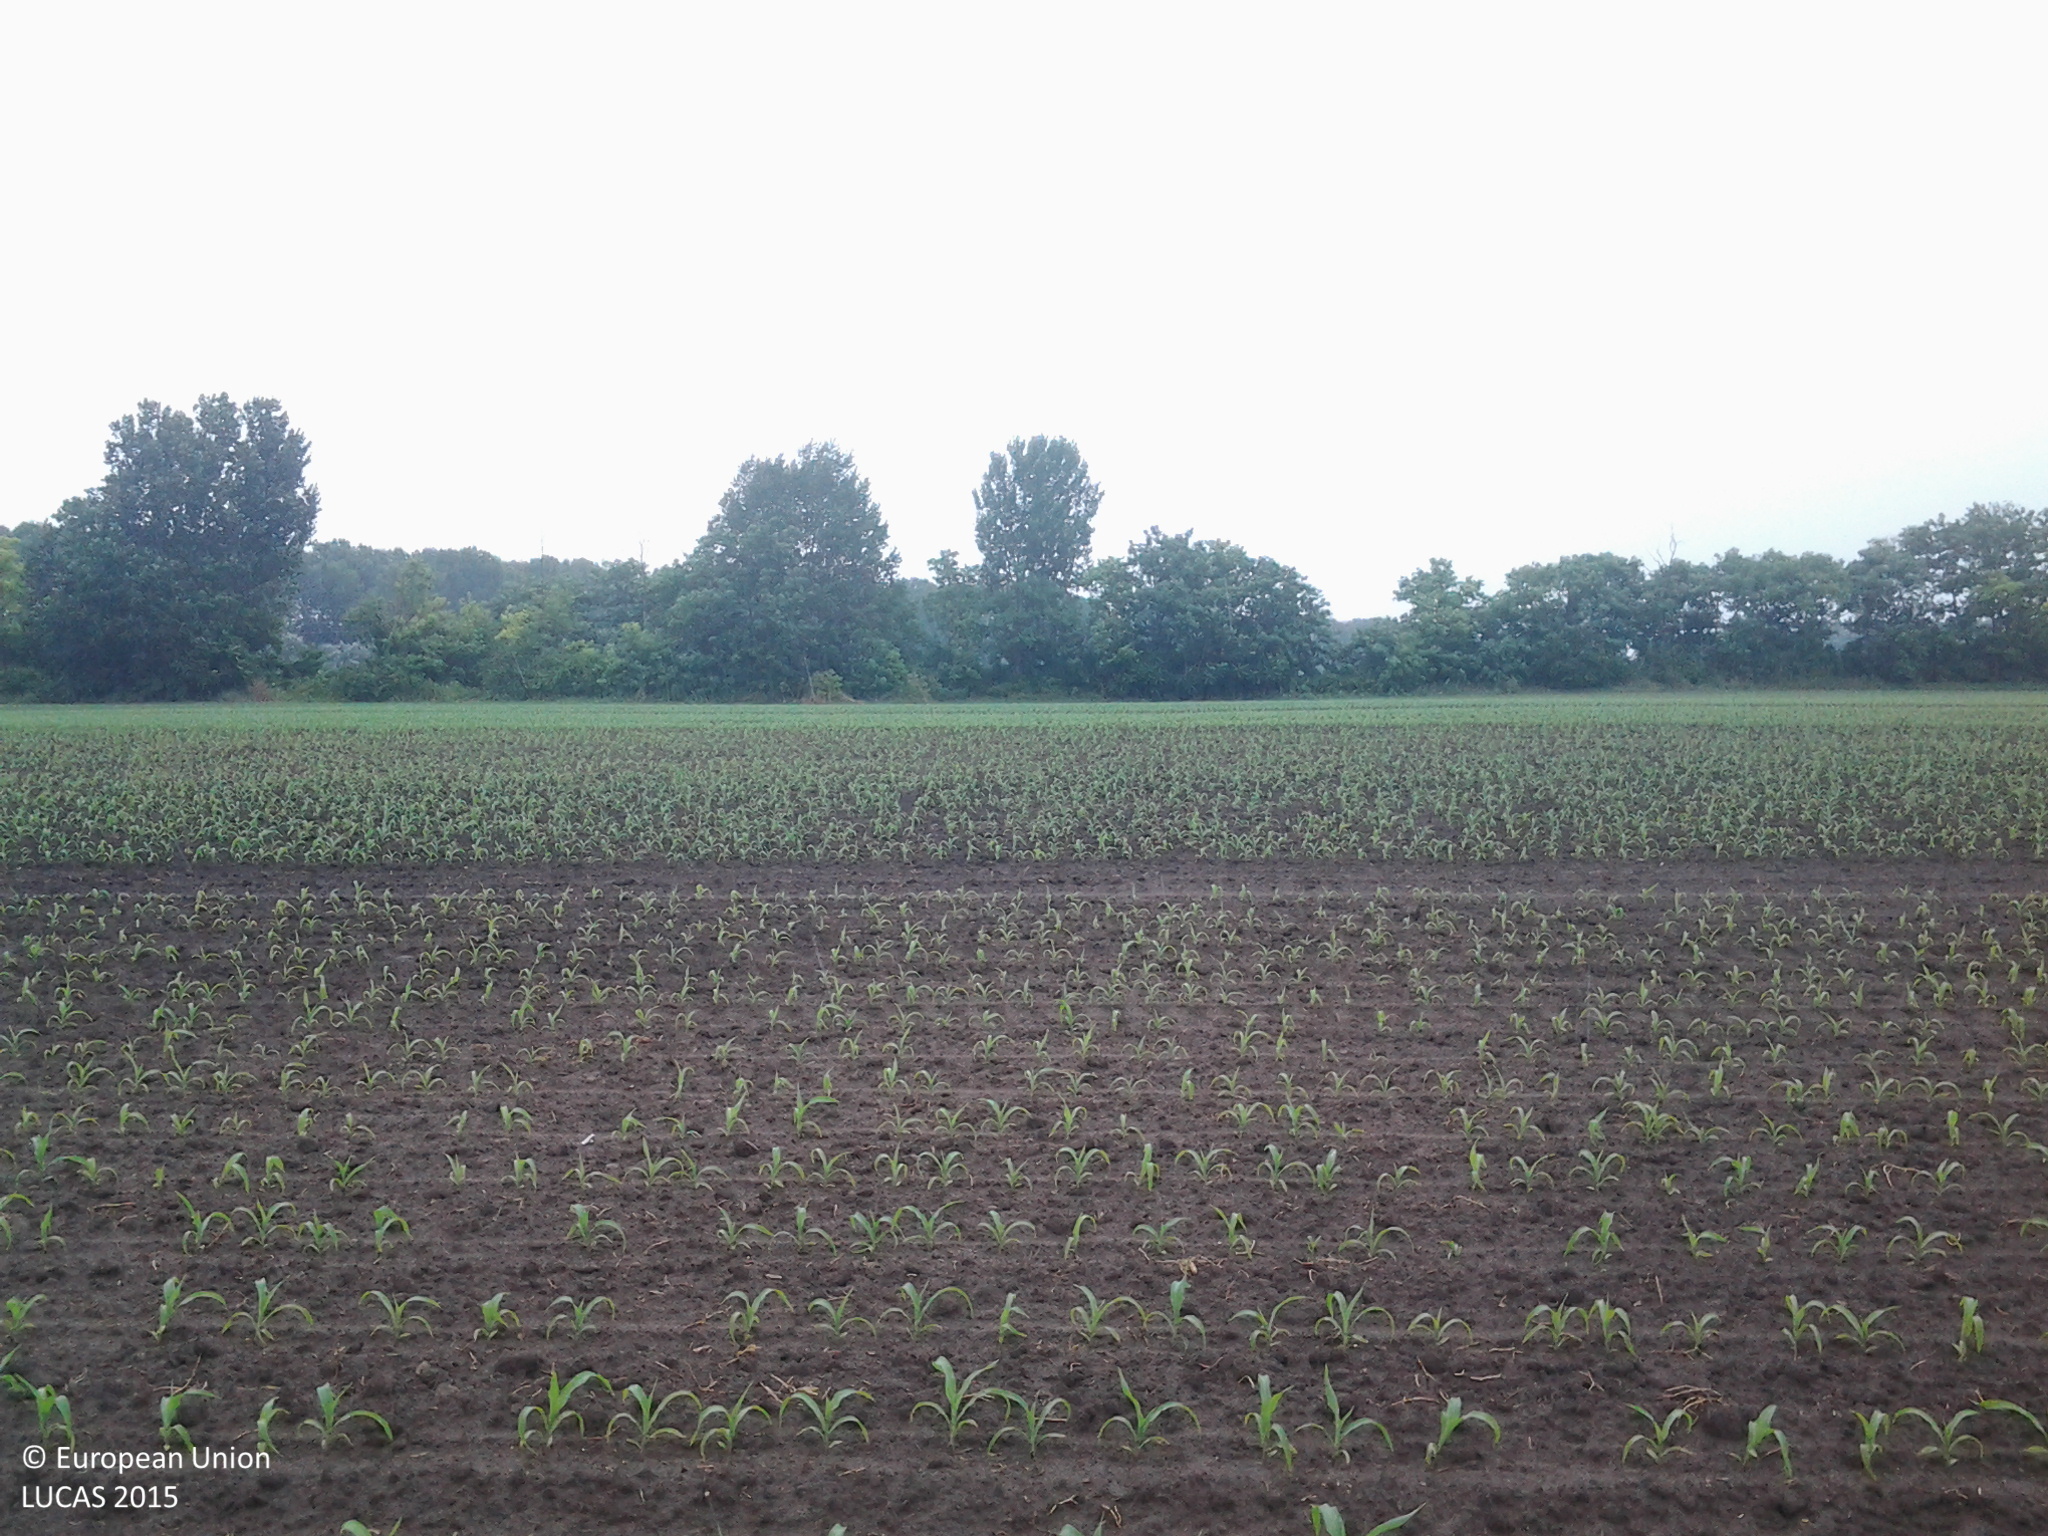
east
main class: Cropland
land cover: Maize
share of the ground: 10 - 25 %
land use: Agriculture (excluding fallow land and kitchen gardens)
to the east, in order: Maize; Broadleaved woodland; Ditches and canals; Grass margins; Paved roads, cycling and walking lanes; Grass margins; Ditches and canals; Other root crops; Tracks; Other root crops
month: July
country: HU
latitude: 46.9215
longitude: 19.1166
